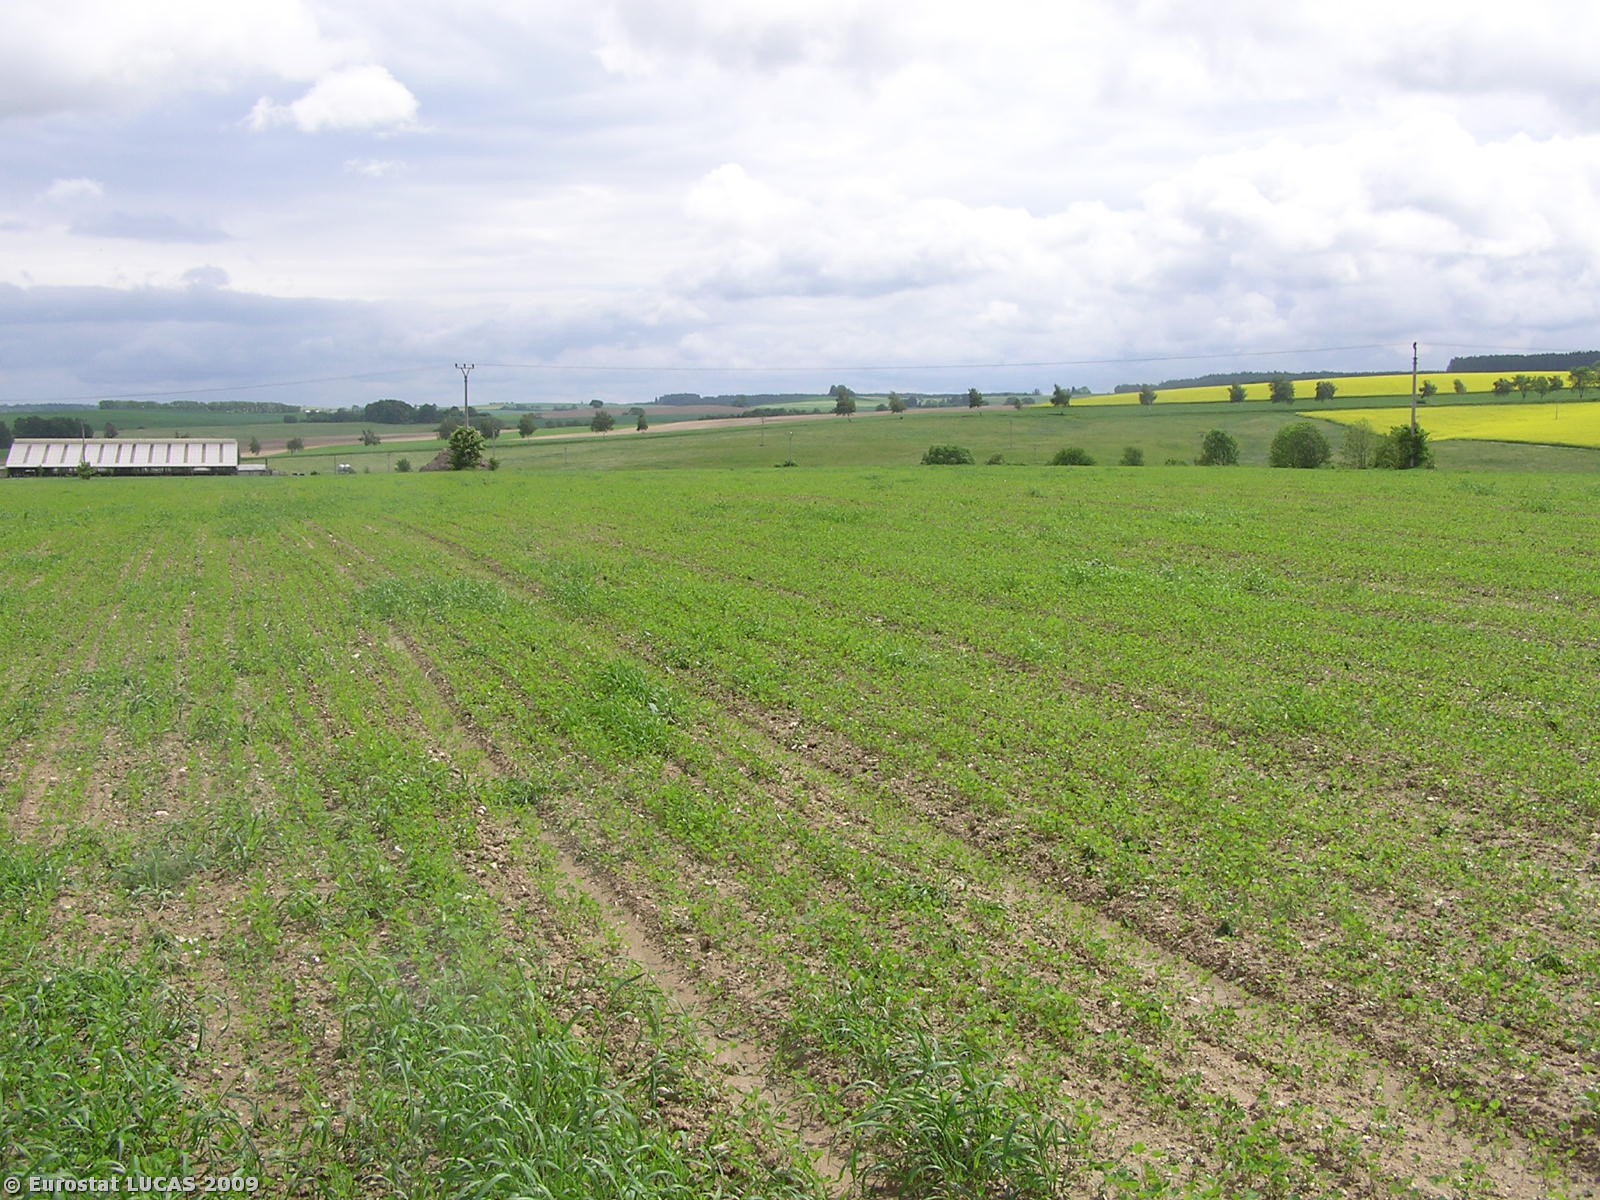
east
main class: Cropland
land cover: Clovers
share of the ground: 50 - 75 %
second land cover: Mixed cereals for fodder
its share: 25 - 50 %
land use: Agriculture (excluding fallow land and kitchen gardens)
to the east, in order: Clovers; Mixed cereals for fodder; Electric lines; Clovers
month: May
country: CZ
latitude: 49.4089
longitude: 14.9778
